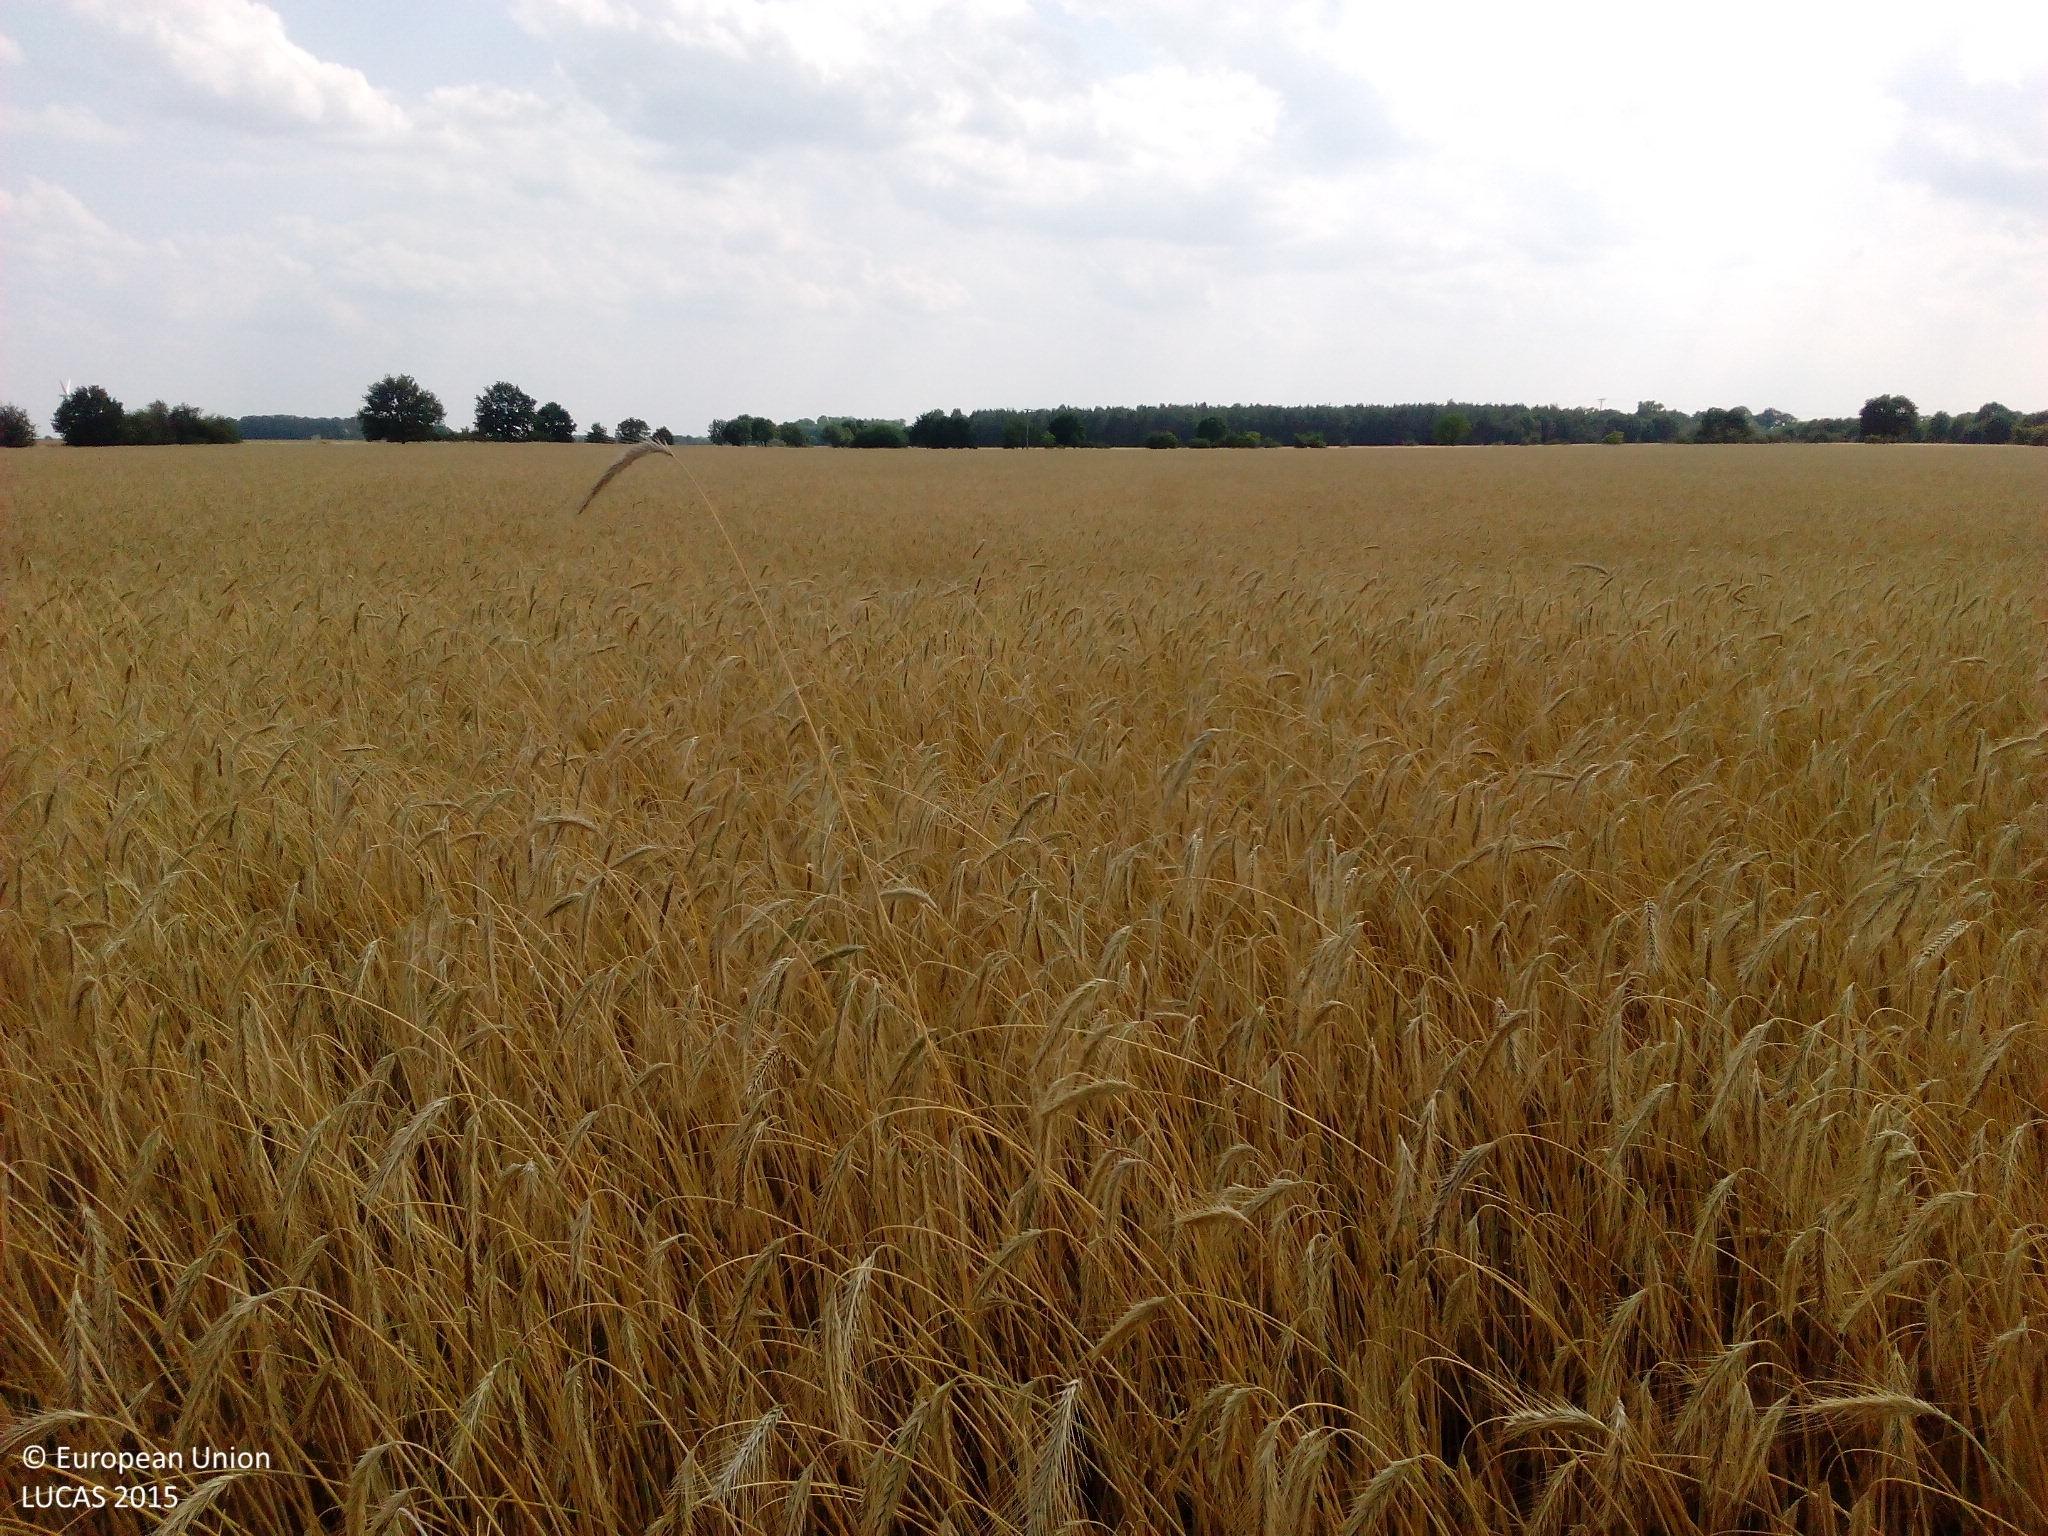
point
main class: Cropland
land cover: Rye
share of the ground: > 75 %
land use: Agriculture (excluding fallow land and kitchen gardens)
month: July
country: DE
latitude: 51.9082
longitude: 12.1655
